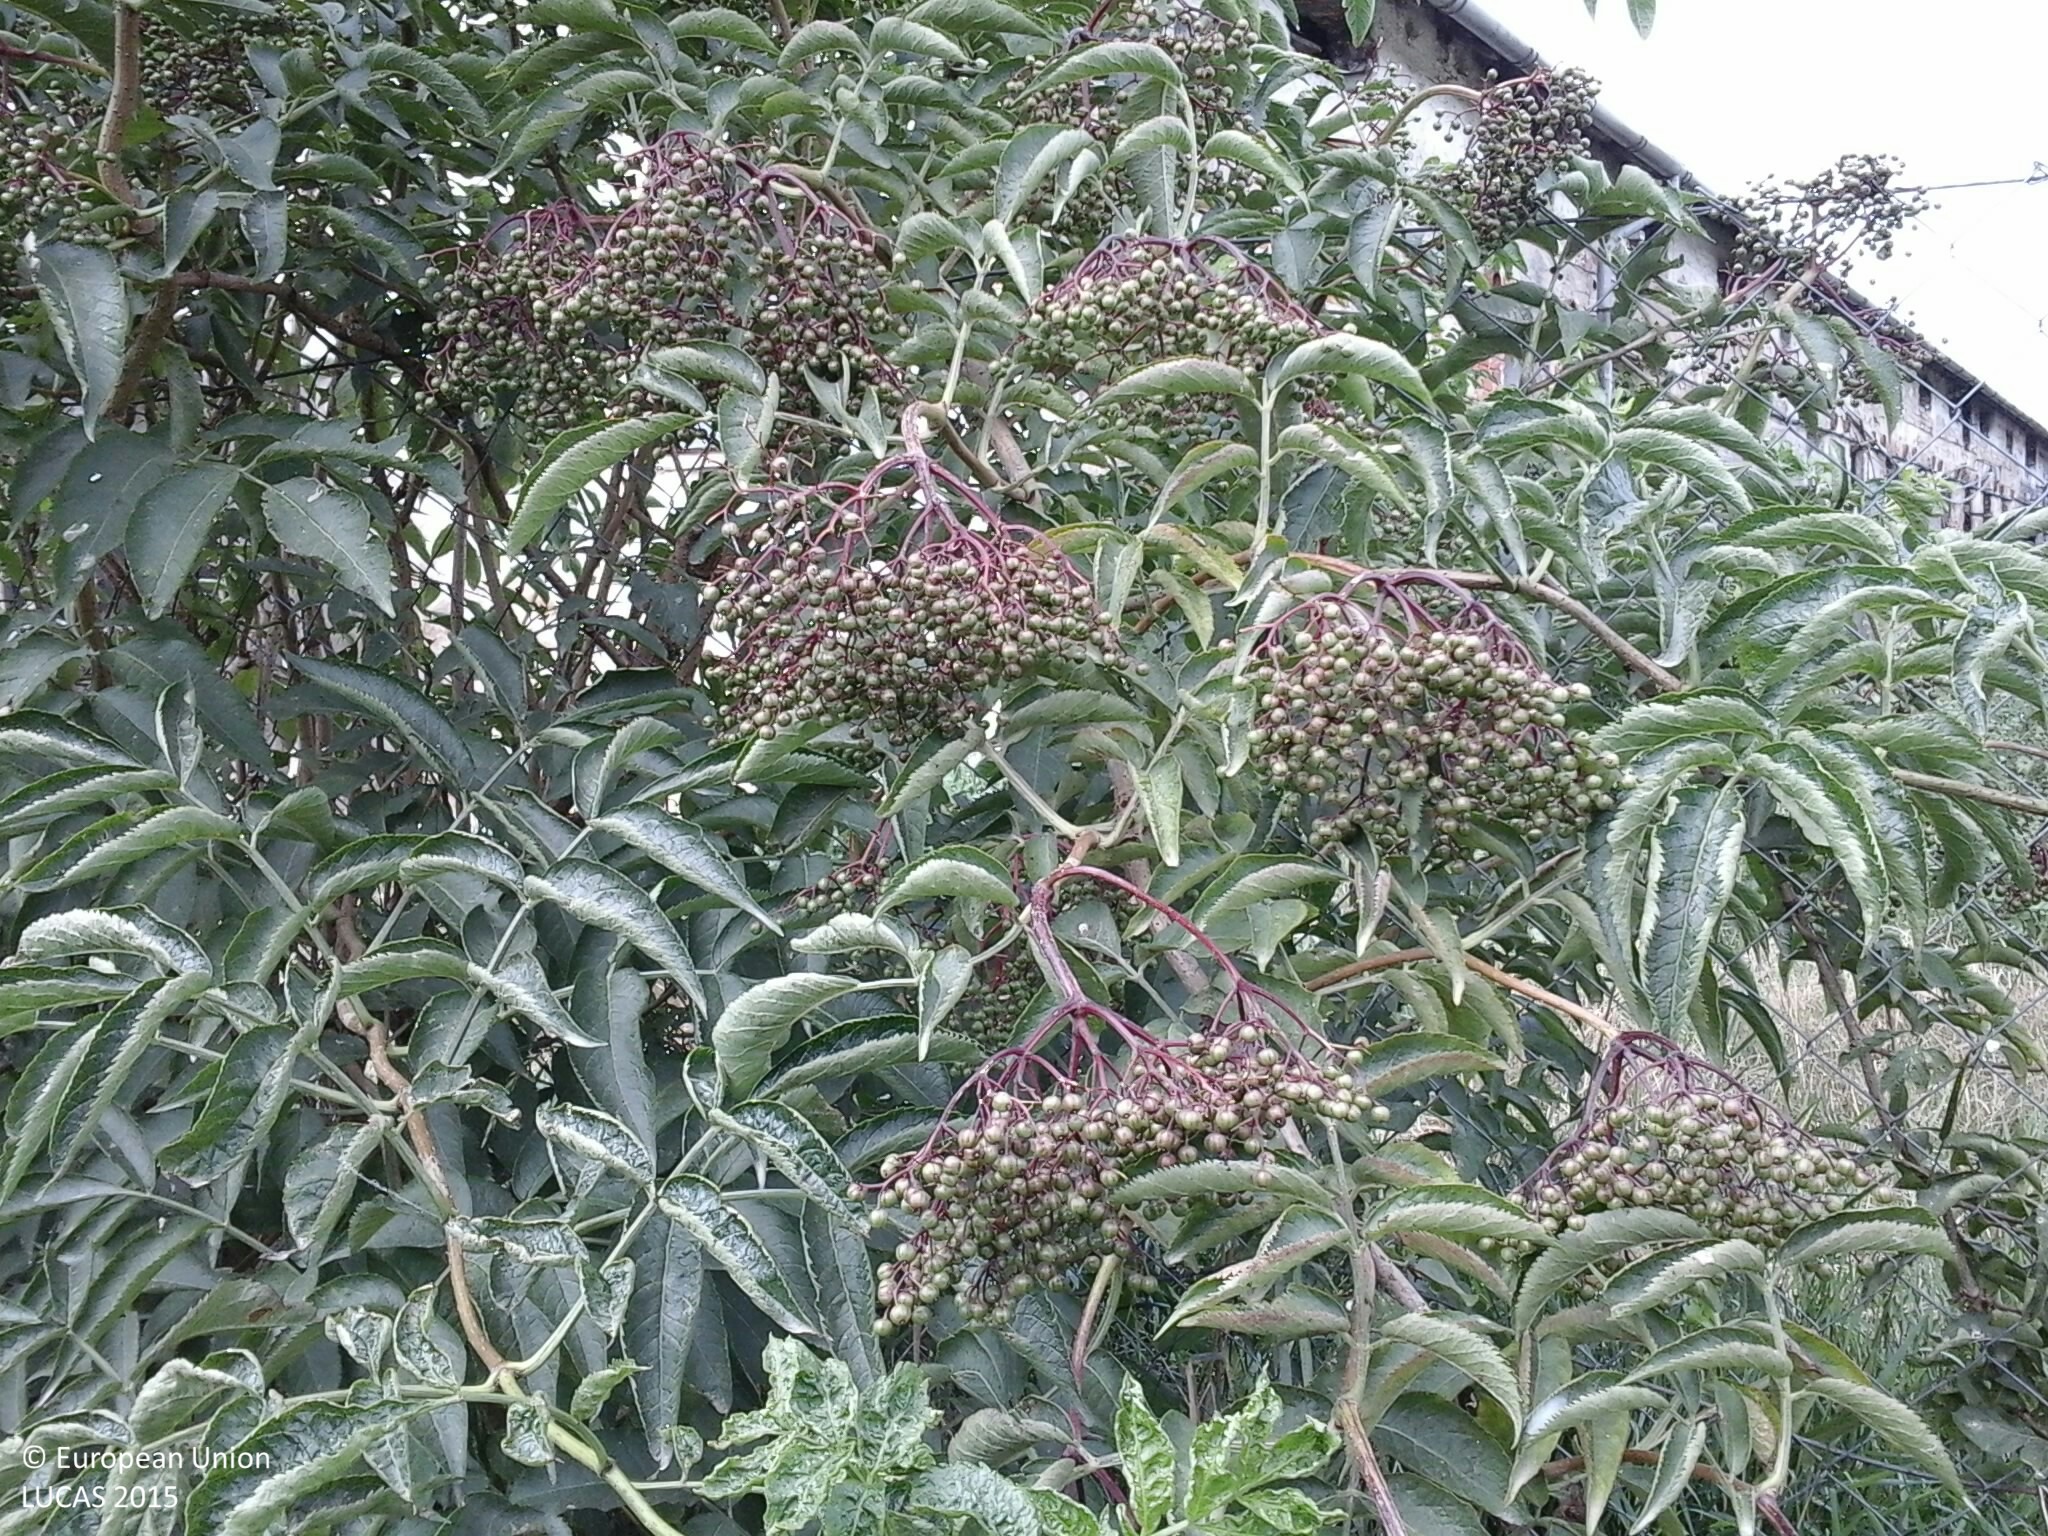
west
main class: Grassland
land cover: Grassland without tree/shrub cover
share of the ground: > 75 %
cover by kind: herbaceous plants 95 %, shrubs 5 %
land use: Road transport
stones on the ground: < 10 %
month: July
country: HU
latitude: 47.0196
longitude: 16.5148
